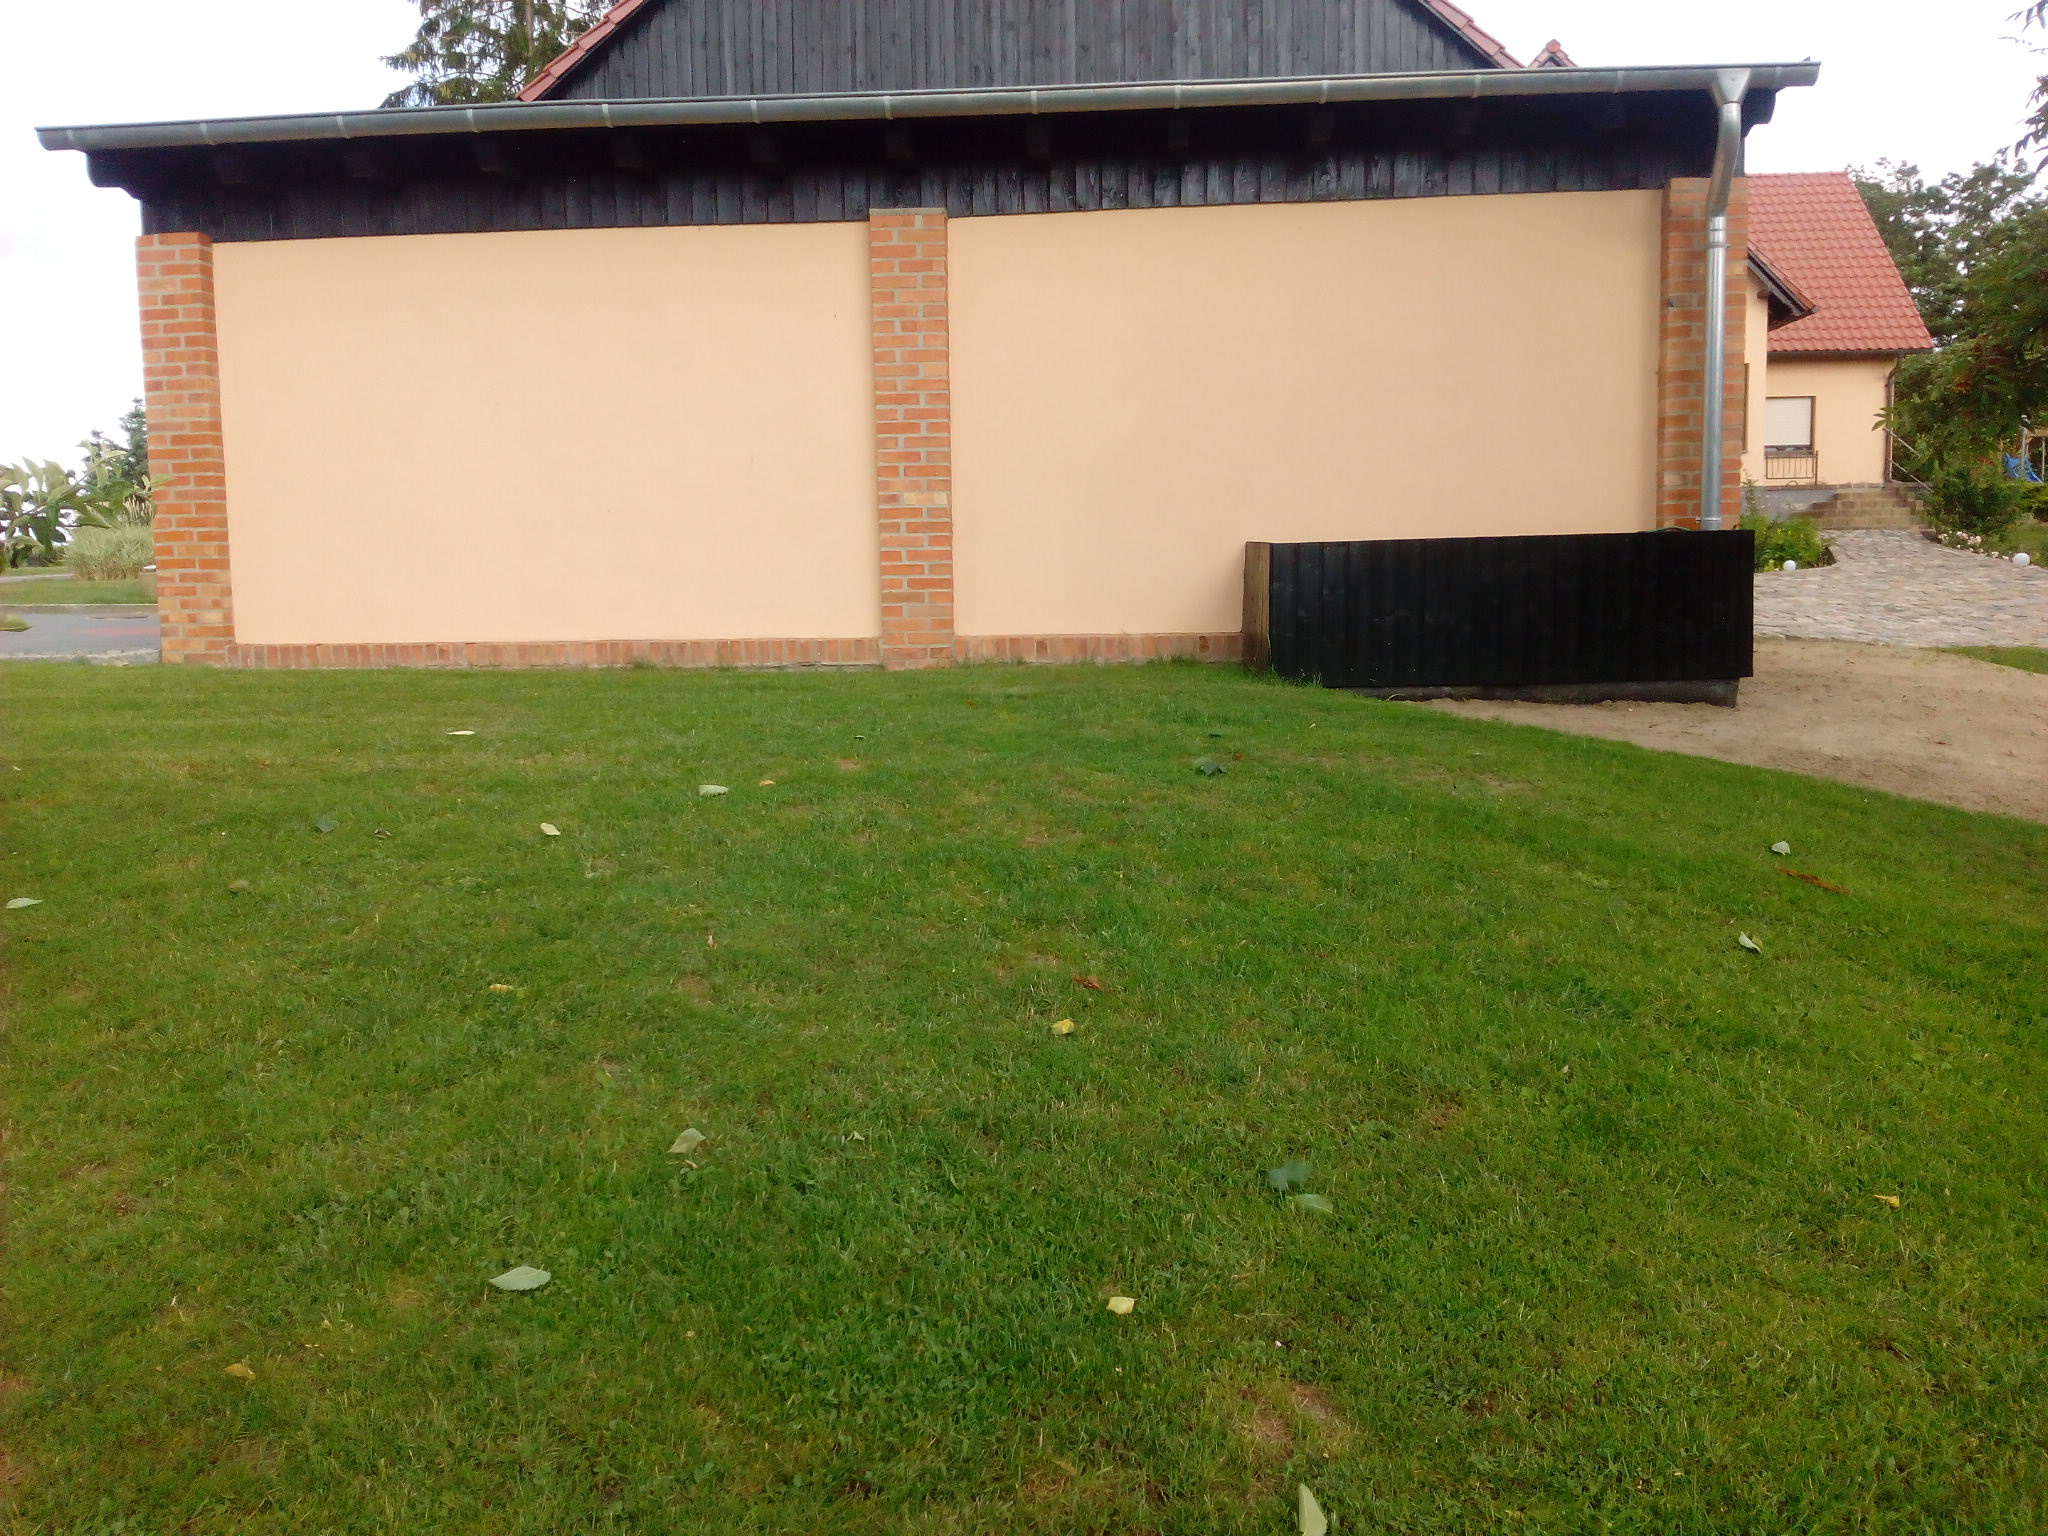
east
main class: Grassland
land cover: Grassland with sparse tree/shrub cover
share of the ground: > 75 %
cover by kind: herbaceous plants 95 %, broadleaved forest trees 5 %
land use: Residential
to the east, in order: Grassland with sparse tree/shrub cover; Artificial constructions in urban areas; Broadleaved woodland; Fences; Grassland without tree/shrub cover; Fences; Grass margins; Barley
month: July
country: DE
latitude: 53.3264
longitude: 14.2798
